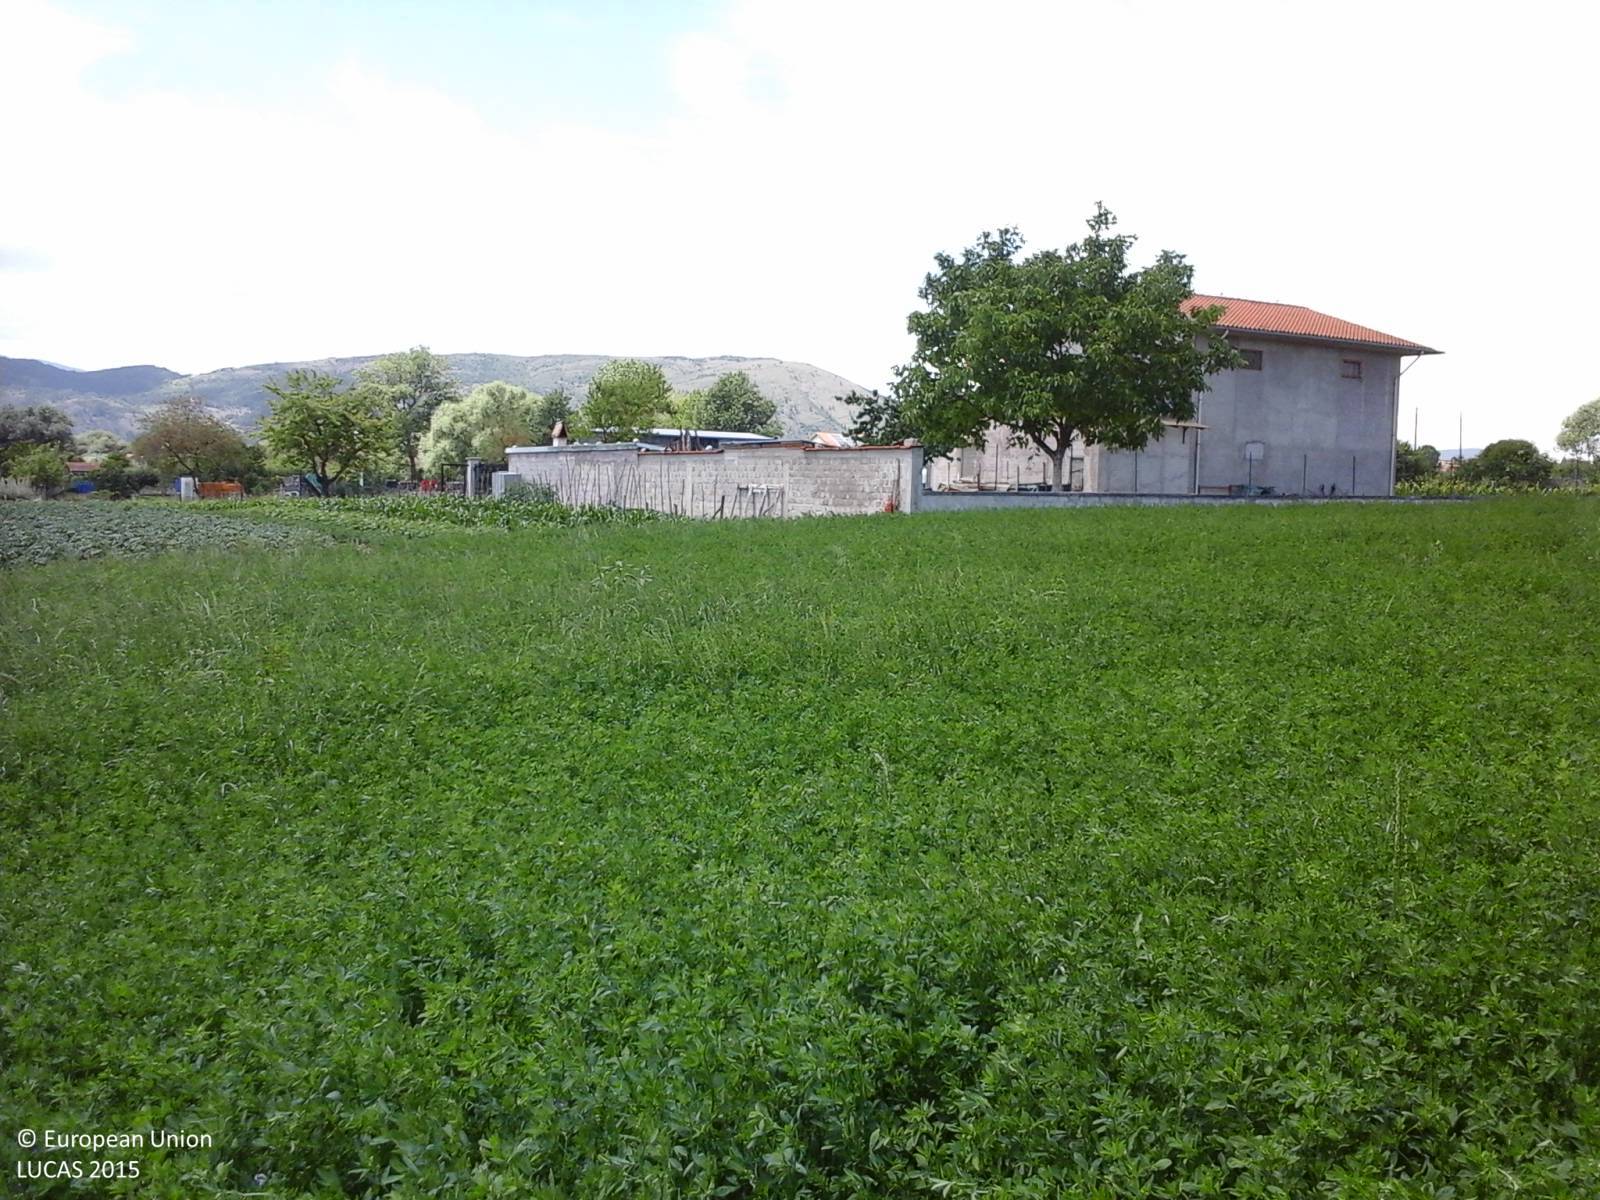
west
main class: Cropland
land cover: Lucerne
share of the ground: > 75 %
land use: Agriculture (excluding fallow land and kitchen gardens)
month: June
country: IT
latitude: 42.0346
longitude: 13.4549
